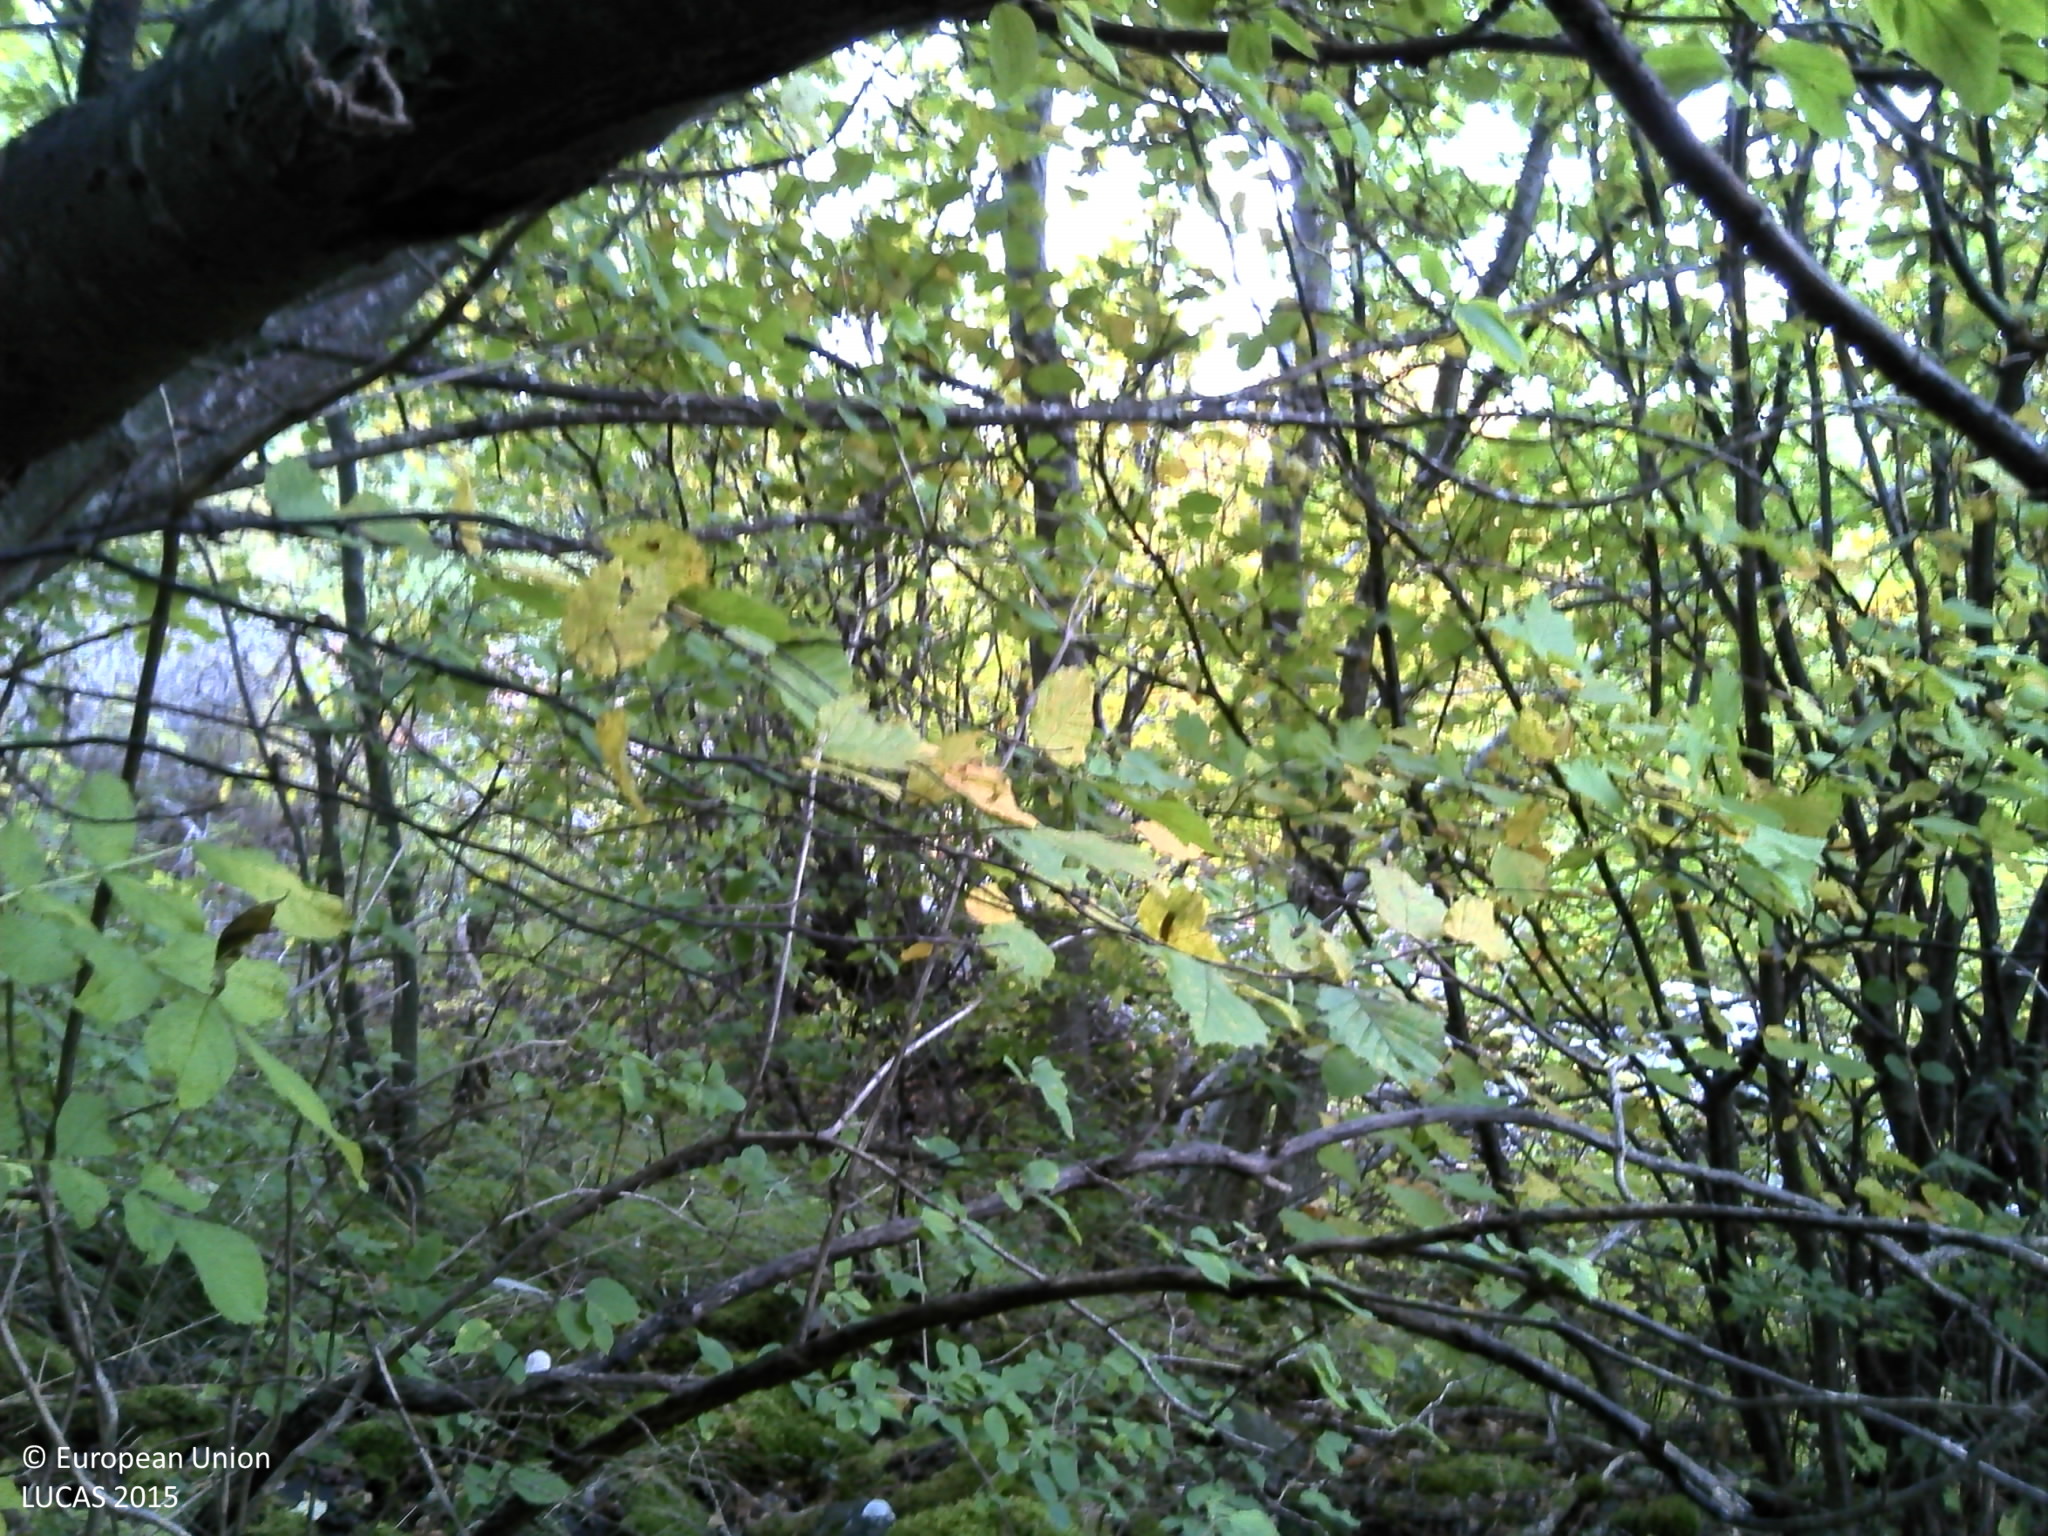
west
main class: Woodland
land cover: Broadleaved woodland
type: mesophytic deciduous forest
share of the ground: > 75 %
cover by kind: broadleaved forest trees 90 %, herbaceous plants 5 %, lichens and mosses 5 %
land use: Forestry
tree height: < 5 m
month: October
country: FR
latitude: 45.4436
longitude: 3.1355
